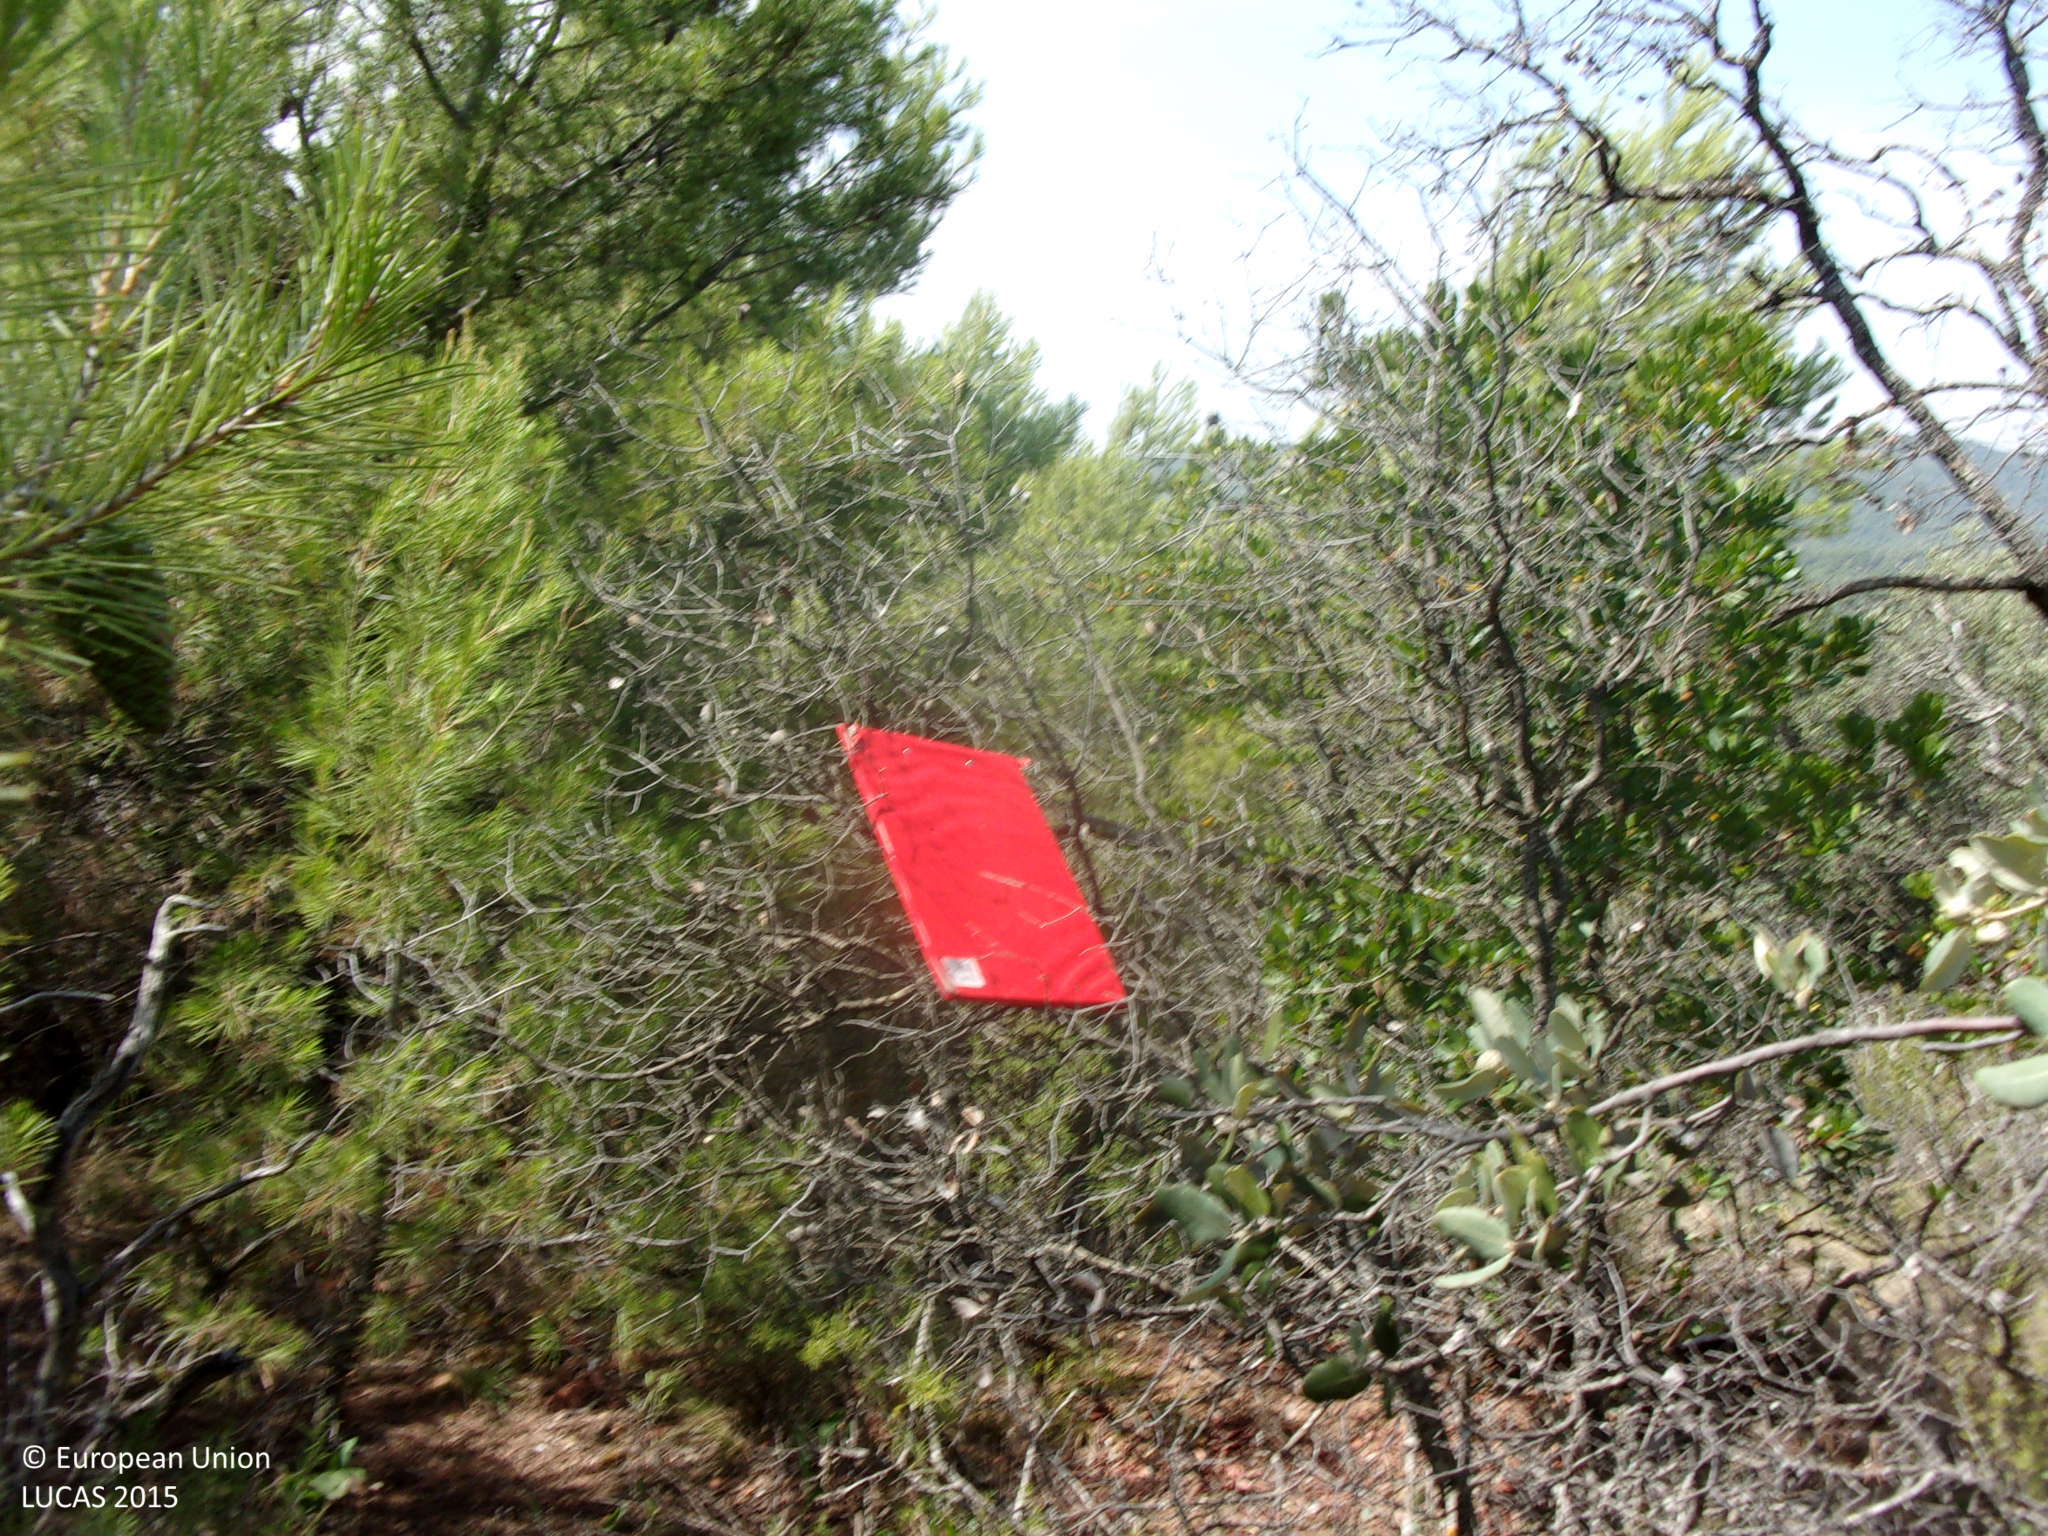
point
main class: Woodland
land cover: Pine dominated mixed woodland
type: coniferous forest of the mediterranean region
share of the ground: > 75 %
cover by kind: coniferous forest trees 60 %, broadleaved forest trees 30 %, shrubs 10 %
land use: Forestry
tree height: < 5 m
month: August
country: ES
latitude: 42.4810
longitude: -1.4079
